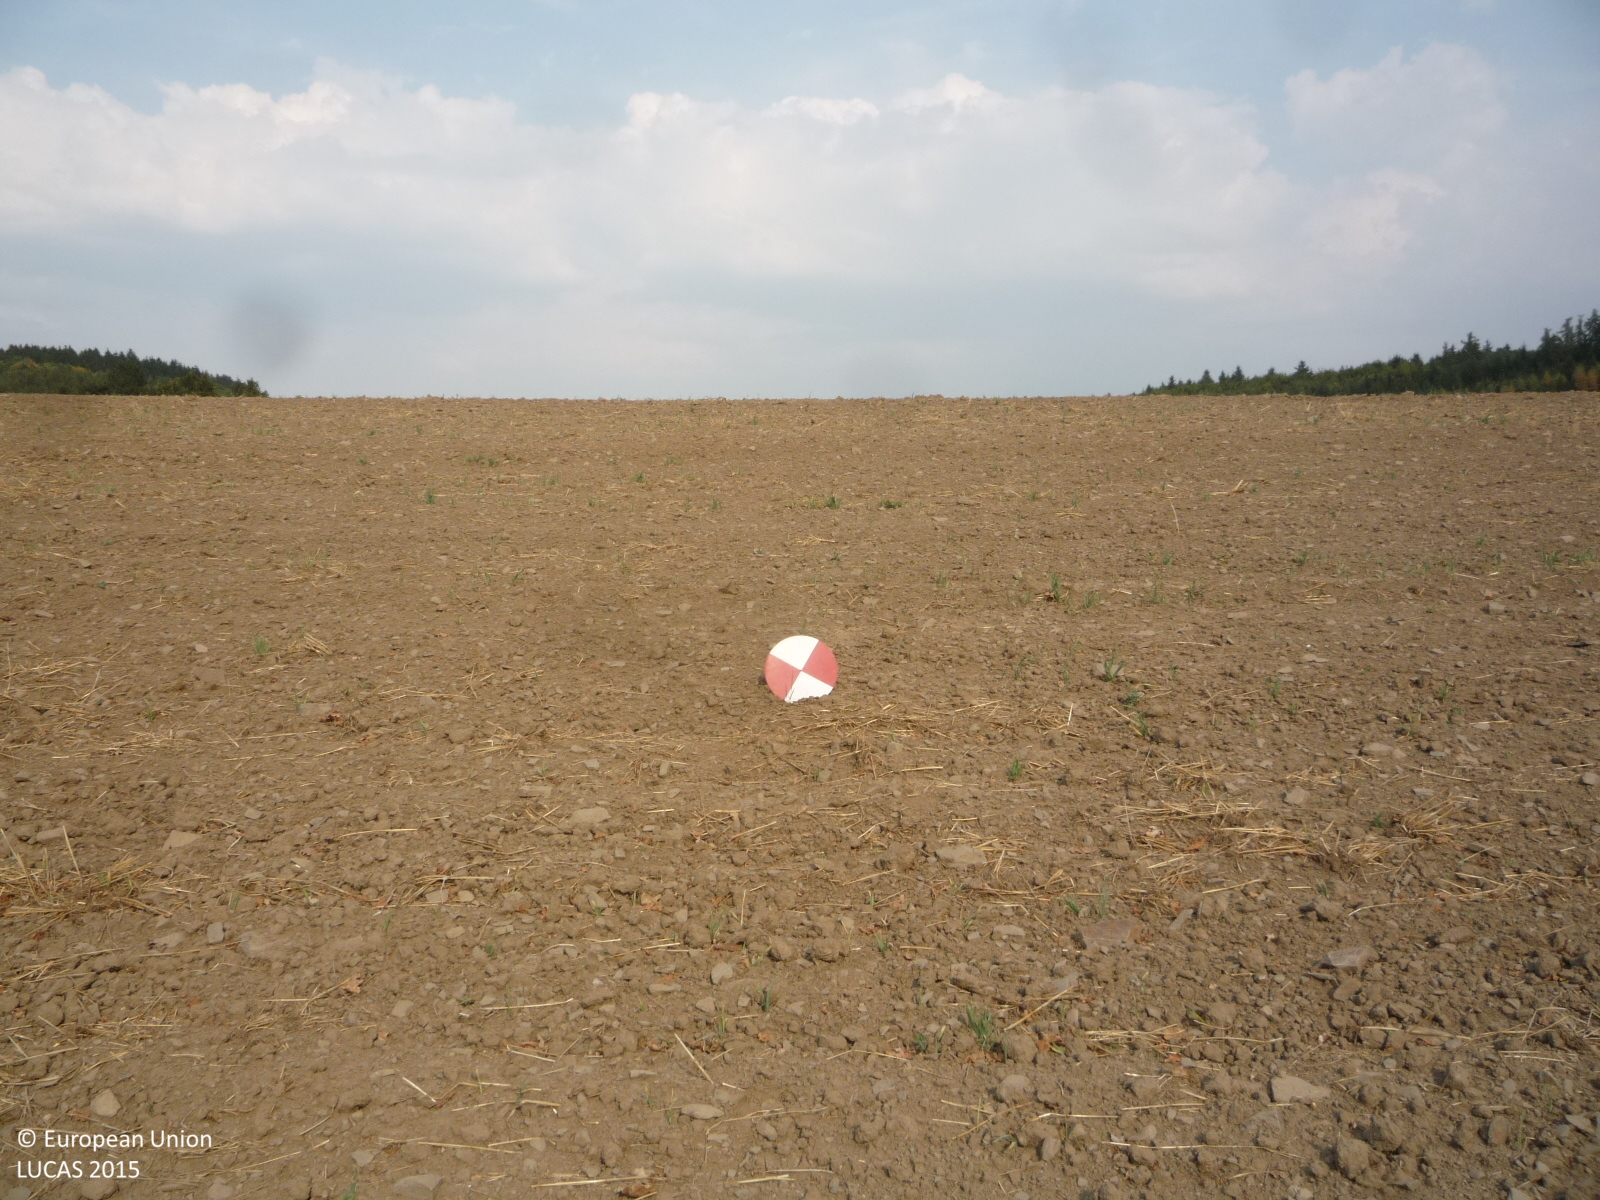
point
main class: Cropland
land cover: Barley
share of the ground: < 10 %
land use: Agriculture (excluding fallow land and kitchen gardens)
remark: Harvested field
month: August
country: CZ
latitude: 49.7897
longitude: 14.4882
